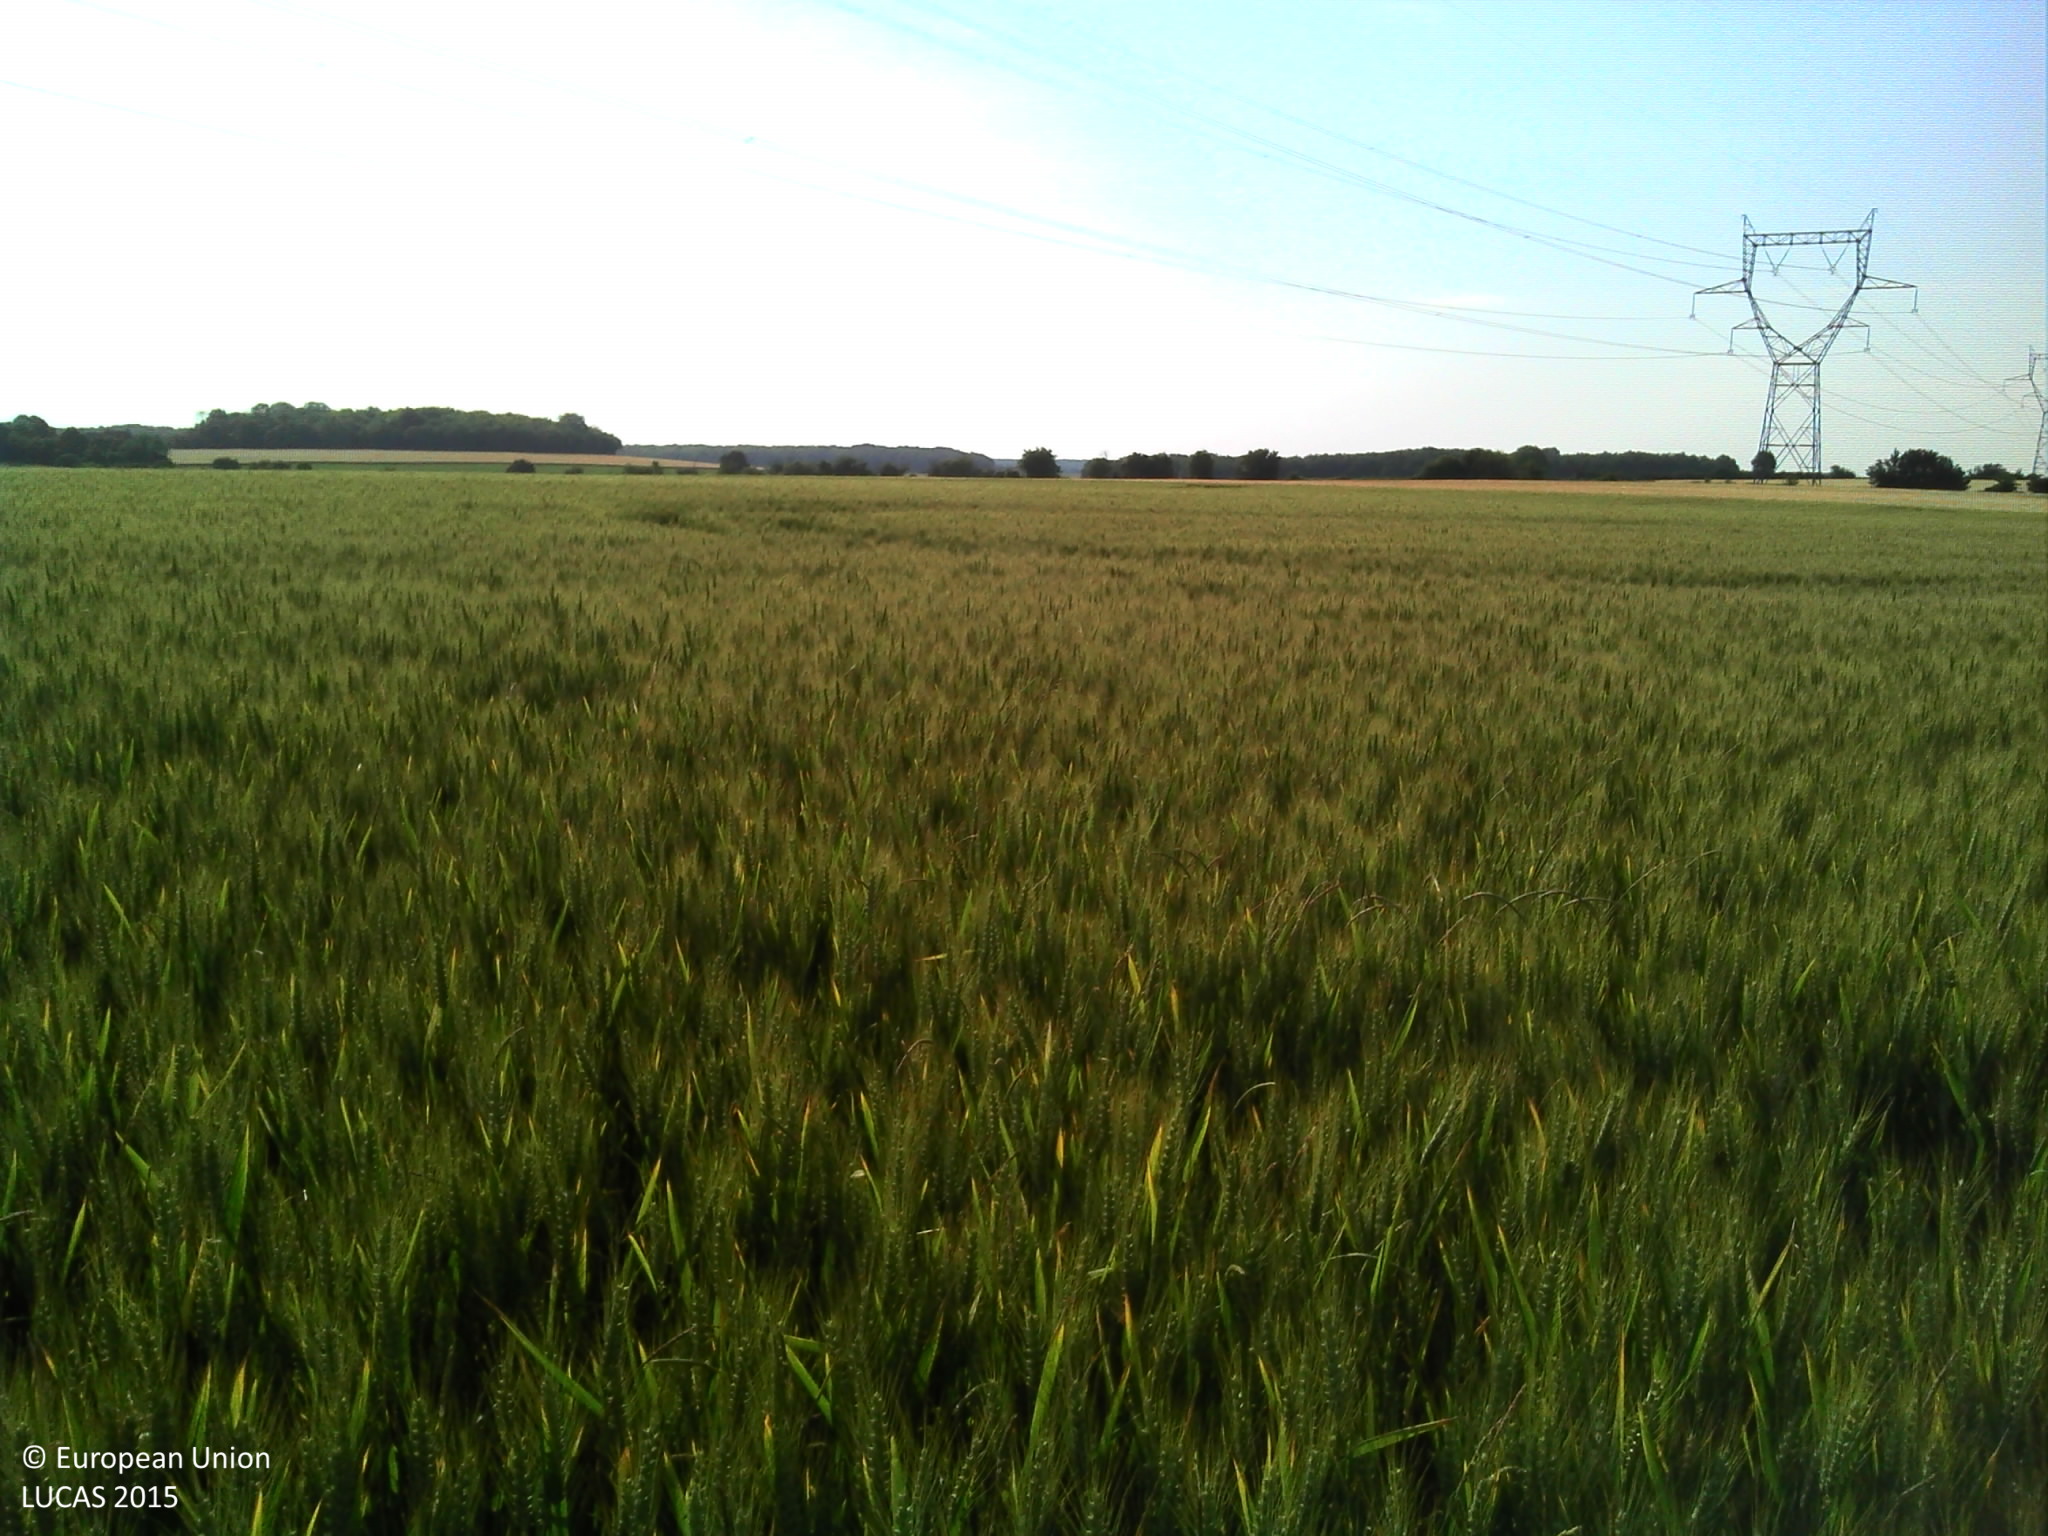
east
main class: Cropland
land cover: Common wheat
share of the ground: > 75 %
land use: Agriculture (excluding fallow land and kitchen gardens)
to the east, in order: Common wheat; Electric lines; Common wheat; Tracks; Barley
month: June
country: FR
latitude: 46.7418
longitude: 2.8102
